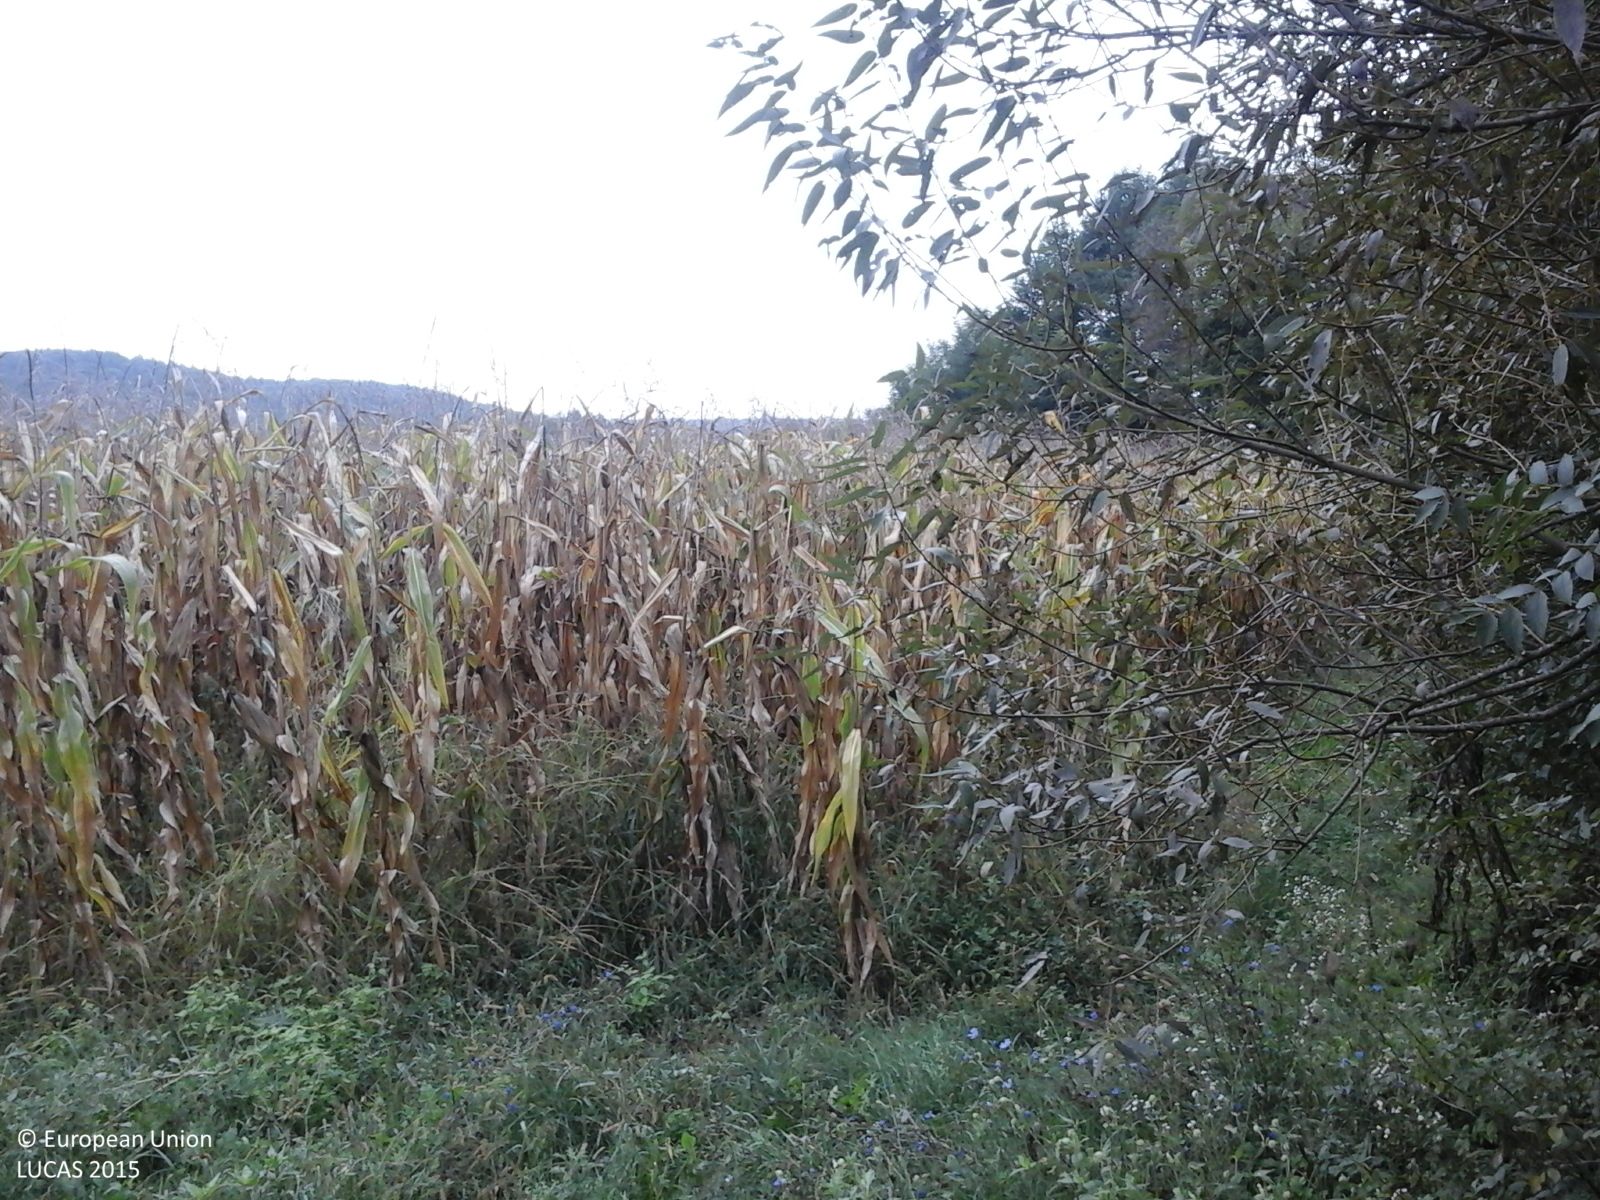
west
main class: Shrubland
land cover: Shrubland with sparse tree cover
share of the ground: > 75 %
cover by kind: shrubs 95 %, broadleaved forest trees 5 %
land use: Semi-natural and natural areas not in use
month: September
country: RO
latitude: 45.9138
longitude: 22.2797
